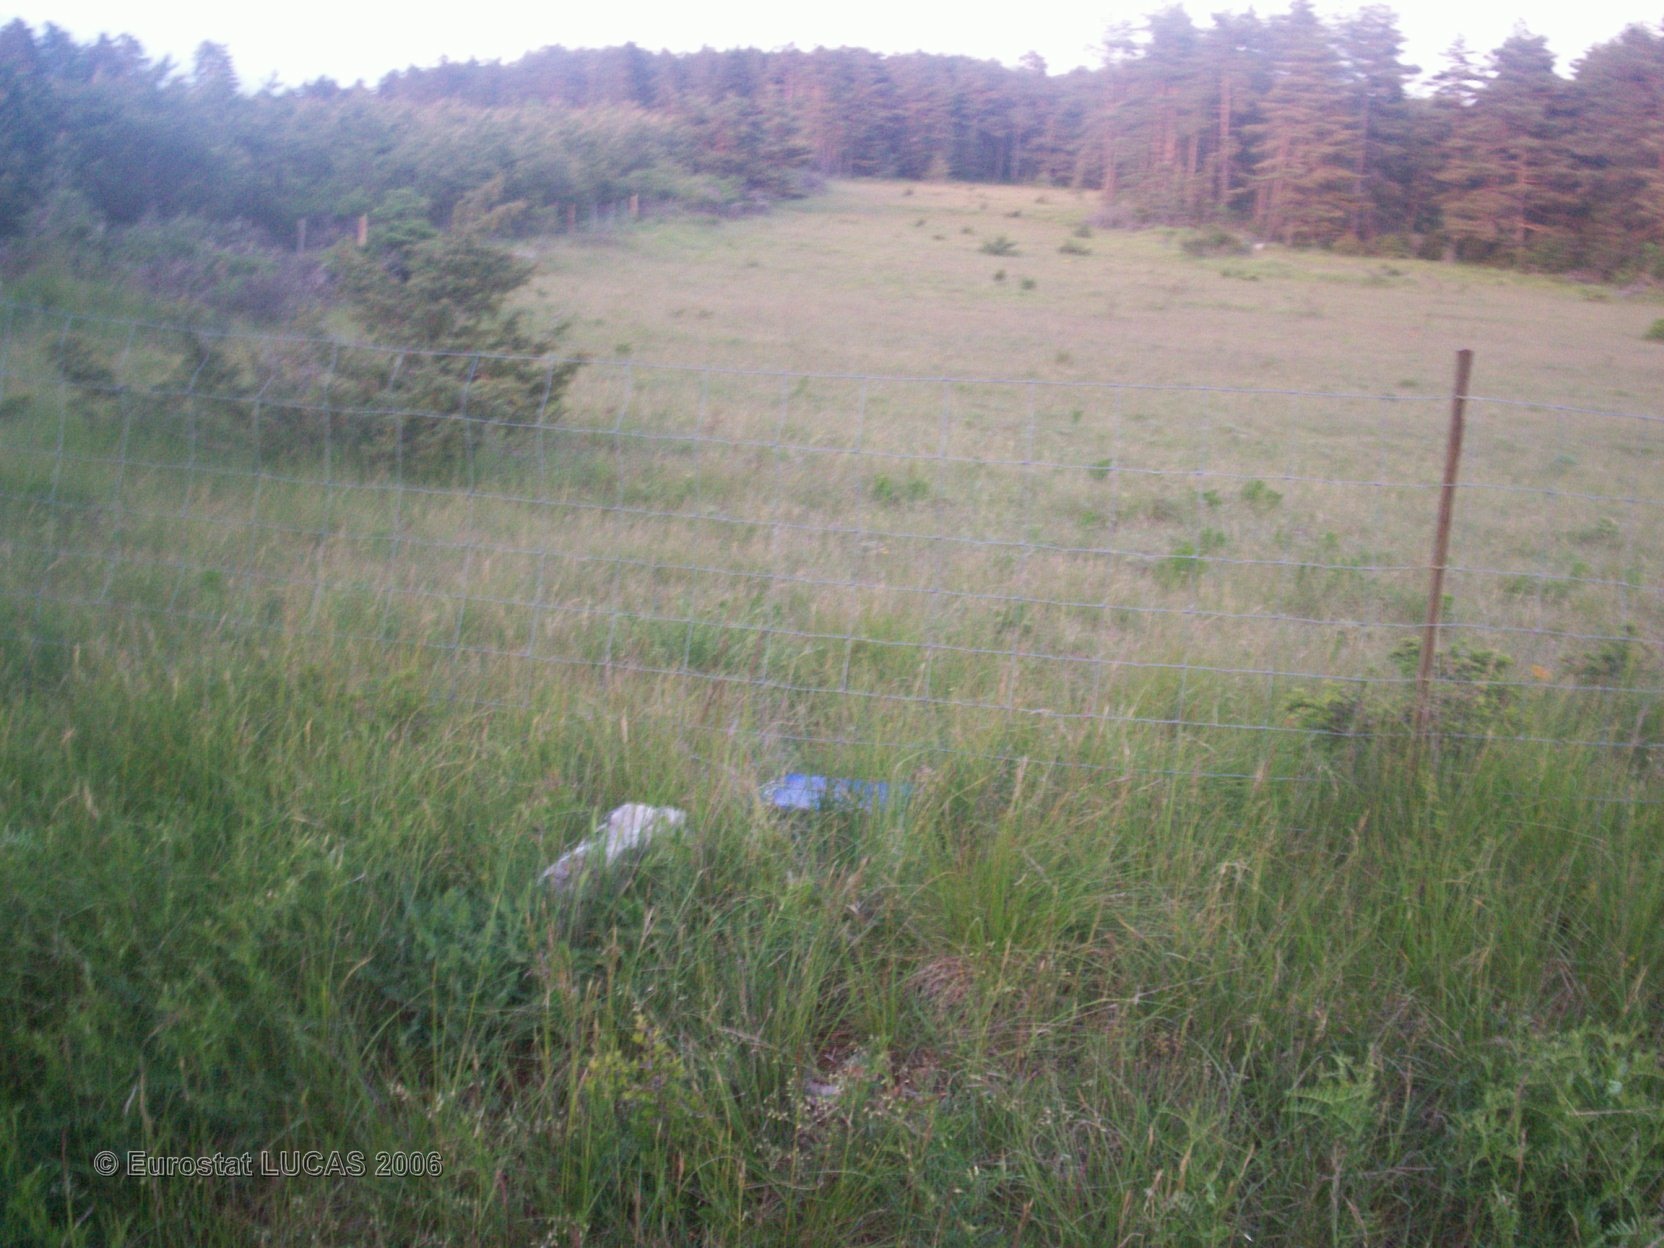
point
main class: Grassland
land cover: Grassland without tree/shrub cover
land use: Agriculture (excluding fallow land and kitchen gardens)
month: June
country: FR
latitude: 44.4484
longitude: 3.4082
